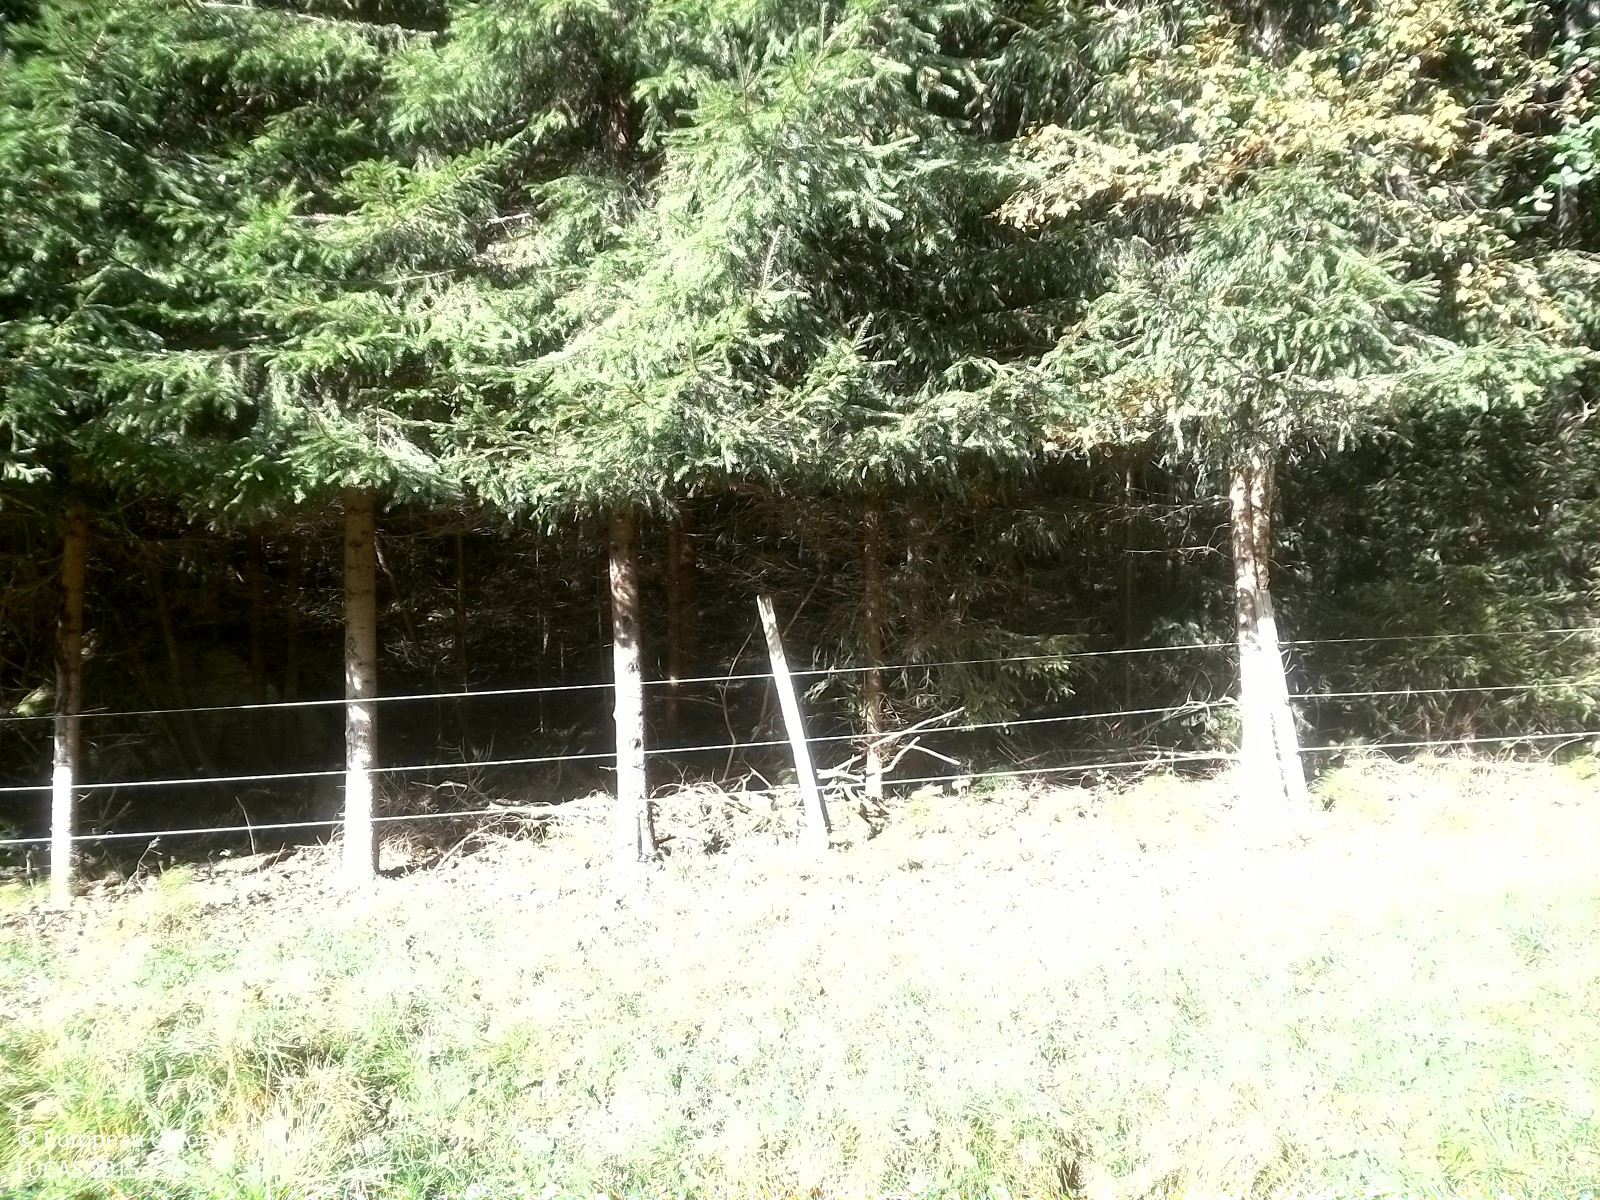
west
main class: Grassland
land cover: Grassland without tree/shrub cover
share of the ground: > 75 %
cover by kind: herbaceous plants 100 %
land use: Agriculture (excluding fallow land and kitchen gardens)
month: September
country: SE
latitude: 58.9582
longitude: 15.8524
